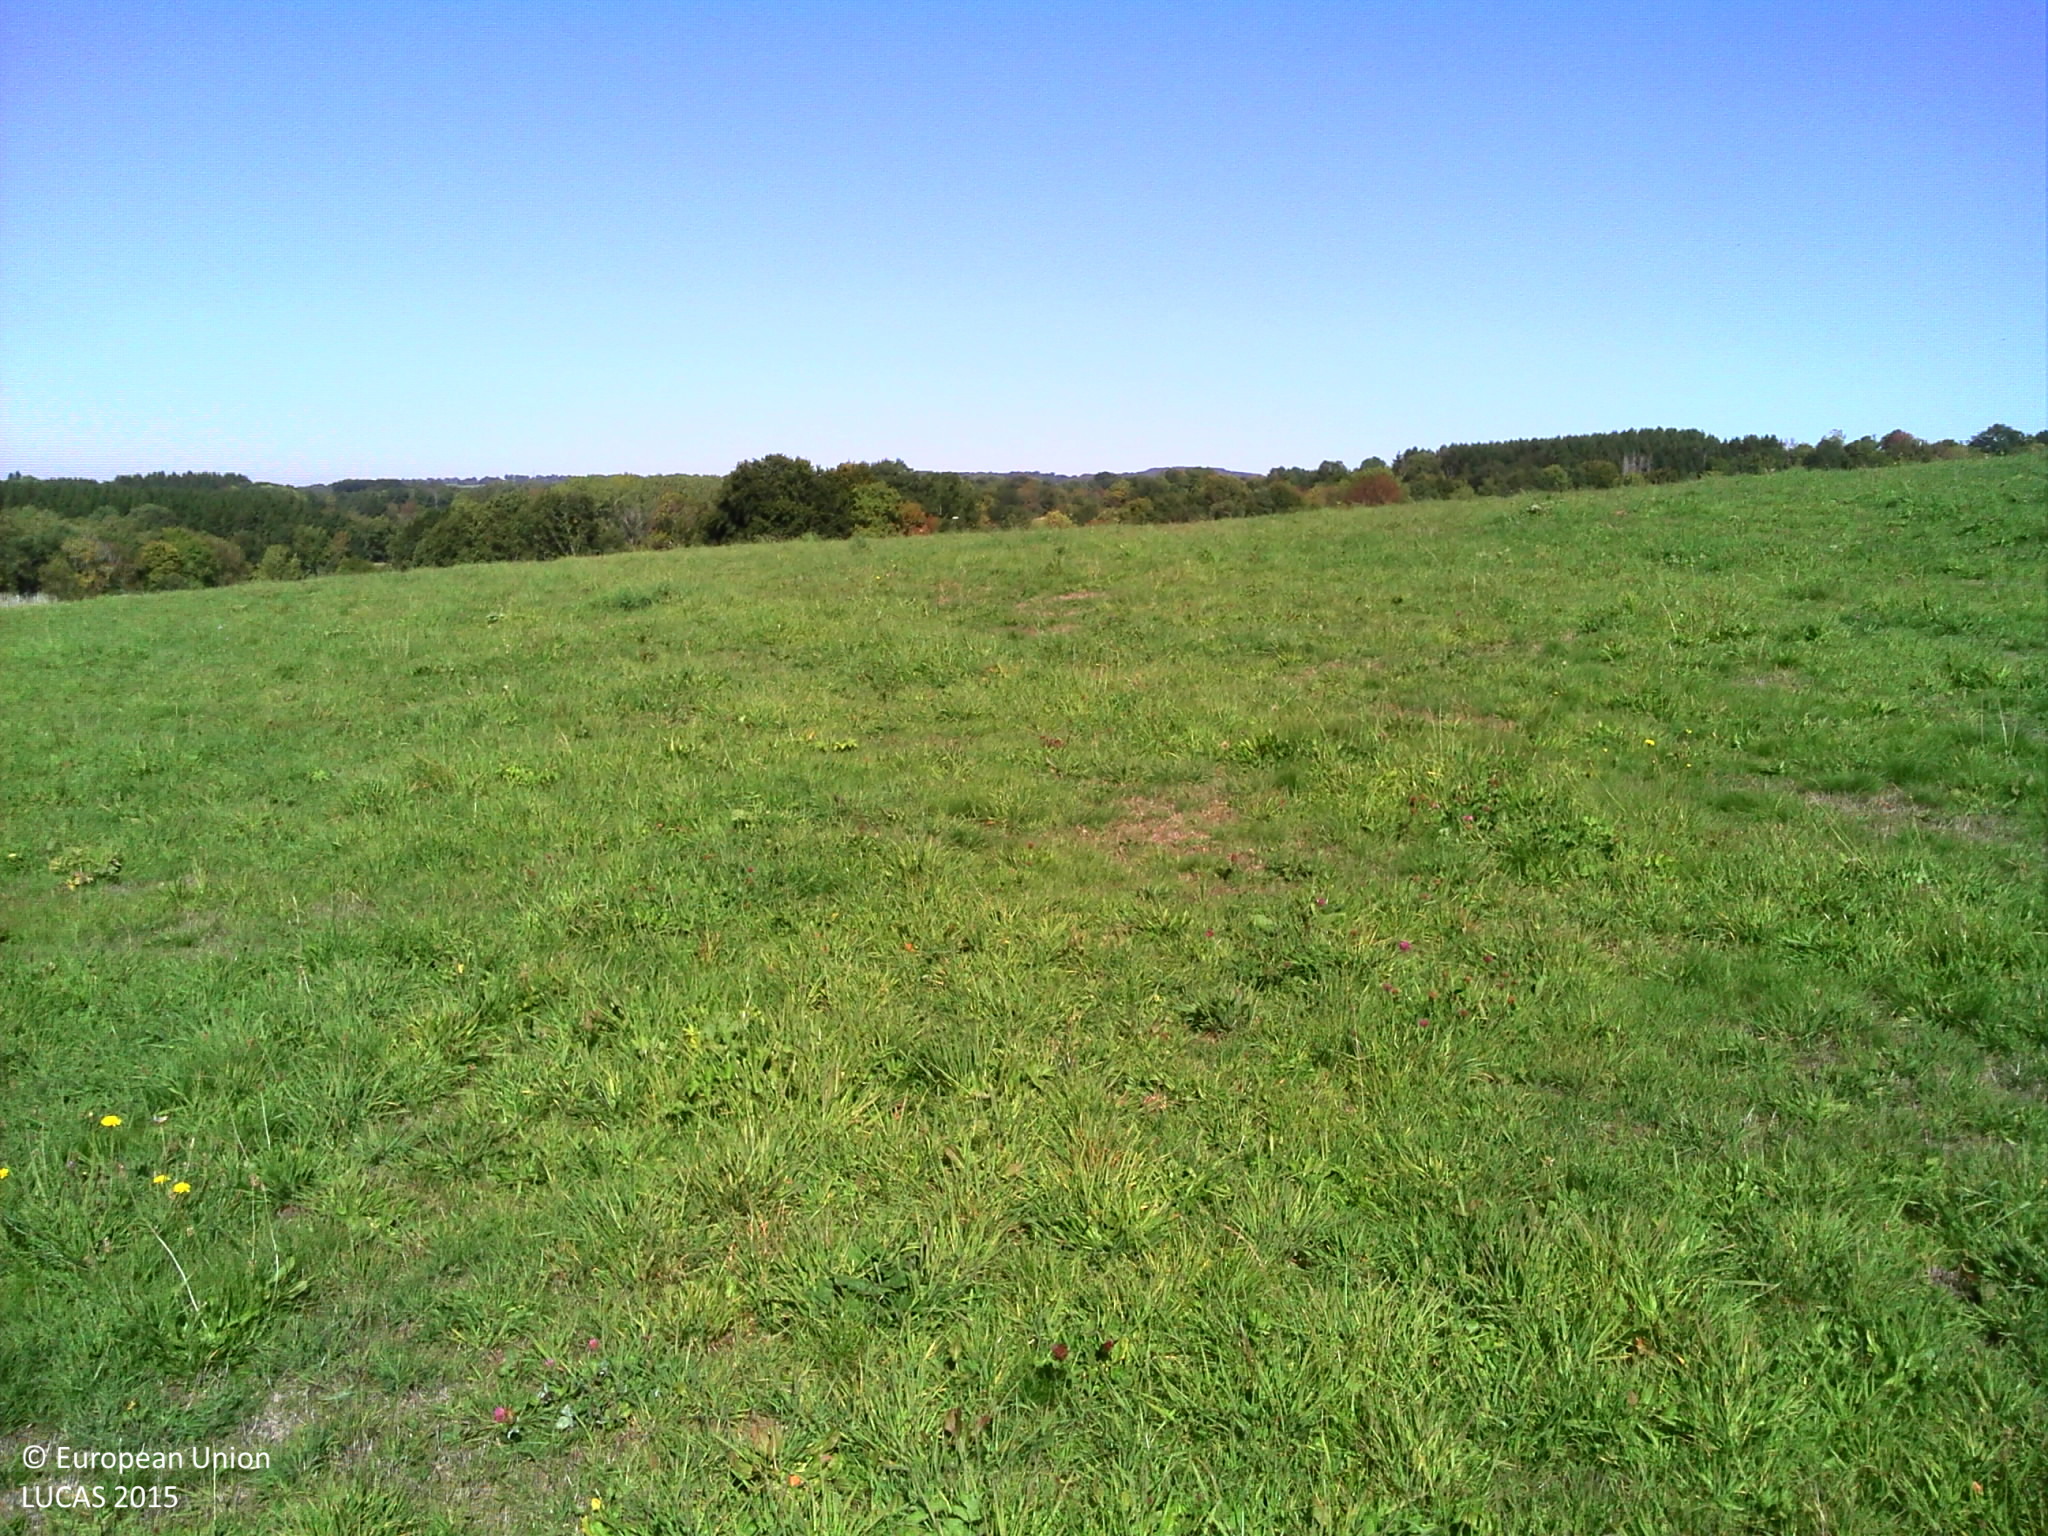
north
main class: Grassland
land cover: Grassland without tree/shrub cover
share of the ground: > 75 %
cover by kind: herbaceous plants 100 %
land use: Agriculture (excluding fallow land and kitchen gardens)
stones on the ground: < 10 %
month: September
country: FR
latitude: 45.8246
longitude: 2.8807
